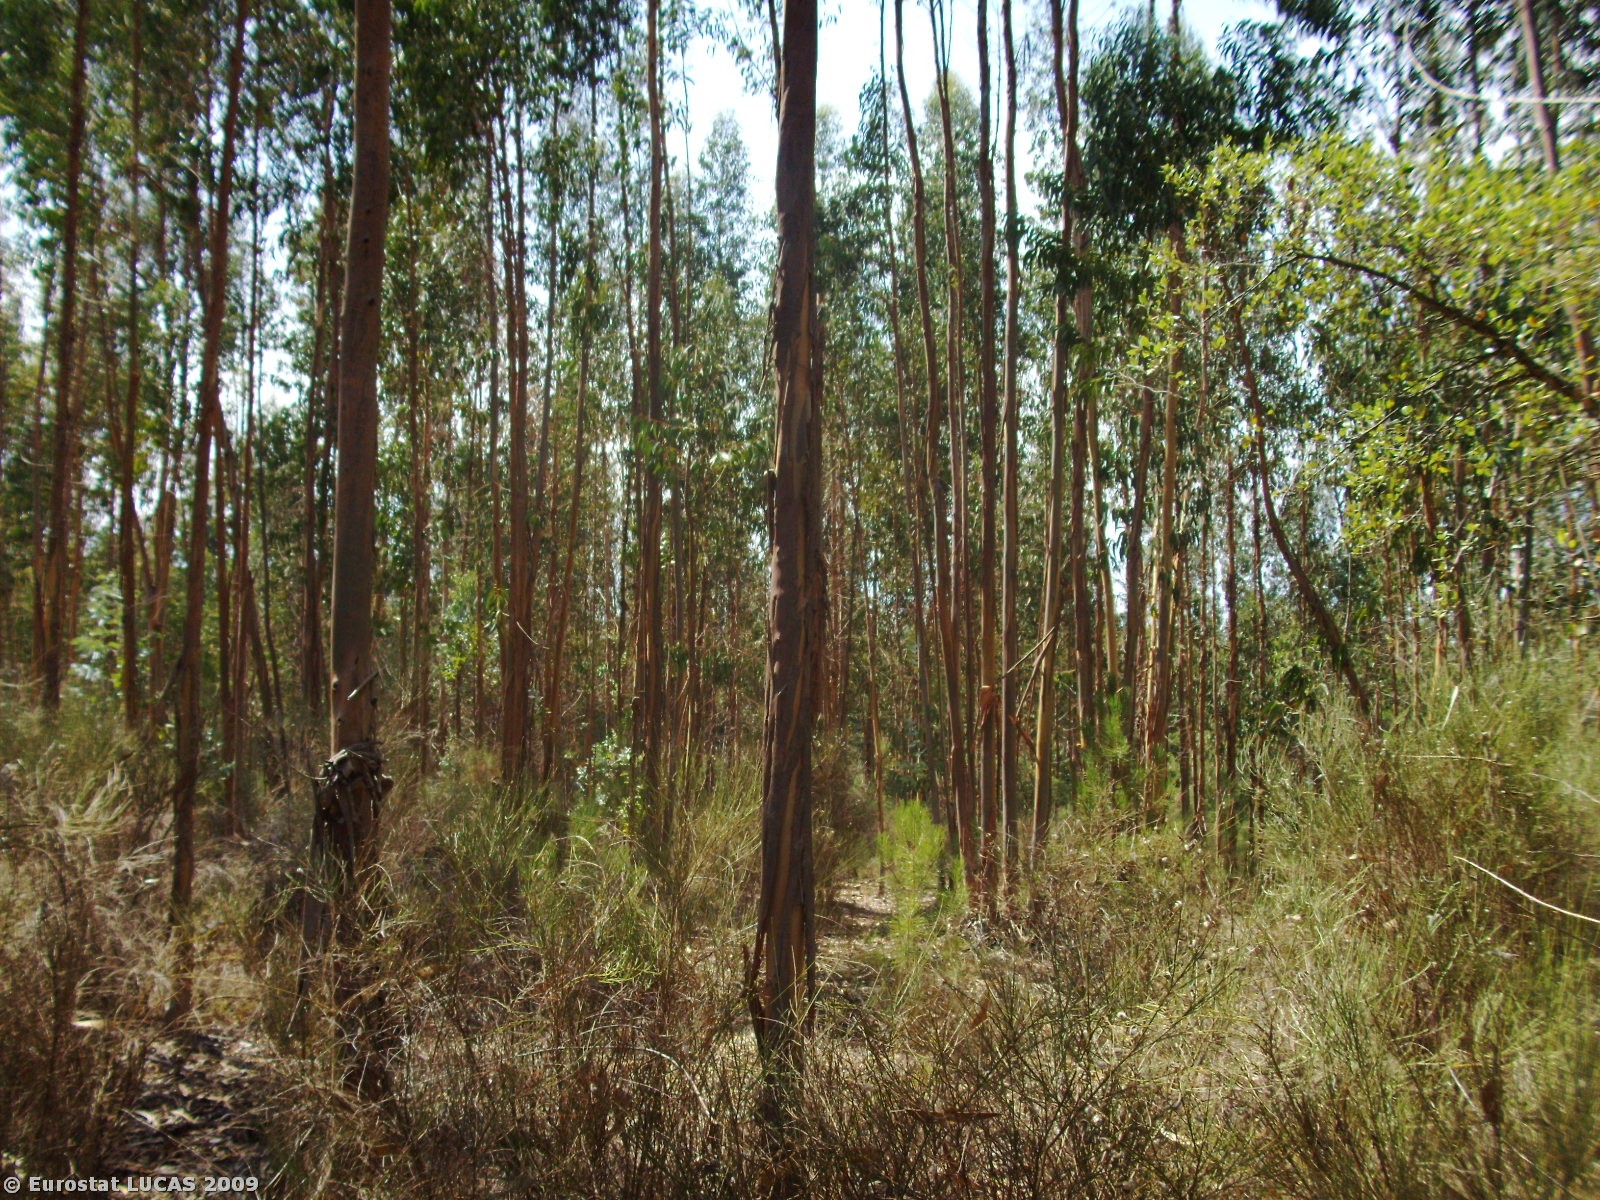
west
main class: Woodland
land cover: Broadleaved woodland
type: plantations and self-sown exotic forest
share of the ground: 50 - 75 %
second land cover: Spontaneously vegetated surfaces
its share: 10 - 25 %
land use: Forestry
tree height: > 5 m
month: August
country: PT
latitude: 39.2828
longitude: -8.1321
